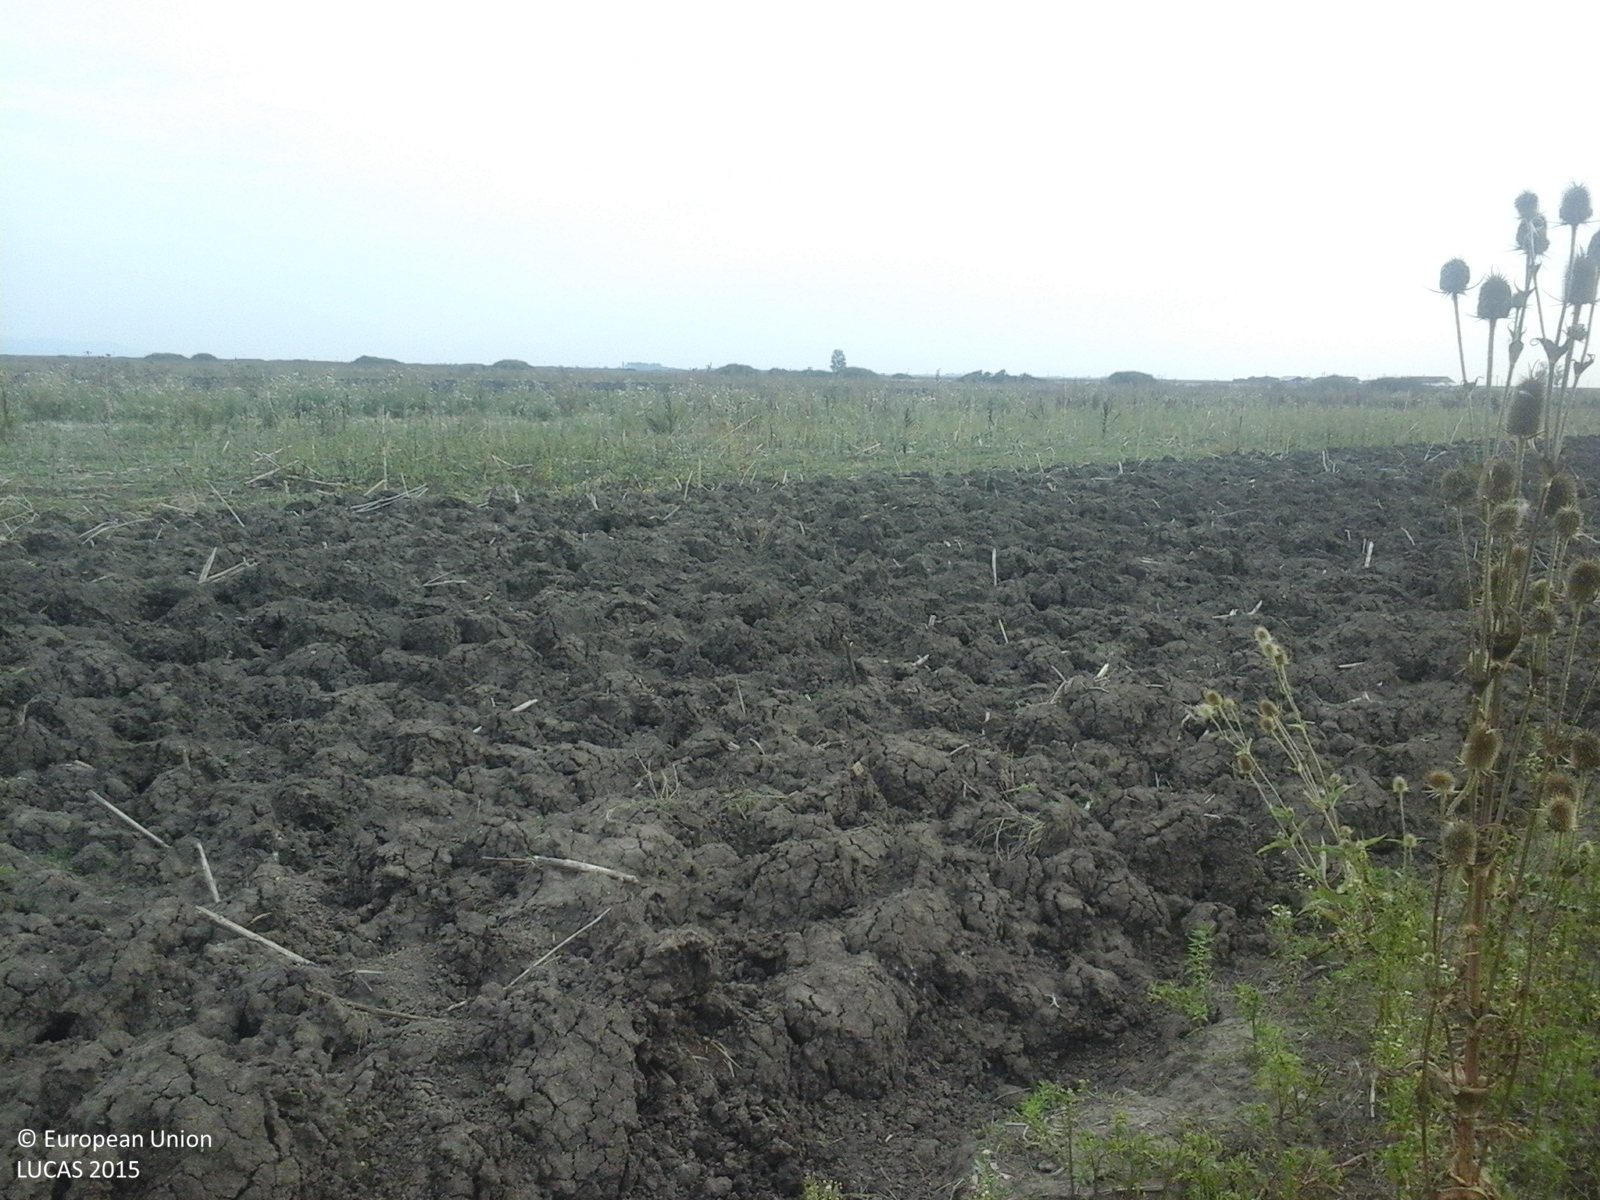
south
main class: Grassland
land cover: Spontaneously vegetated surfaces
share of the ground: > 75 %
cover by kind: herbaceous plants 100 %
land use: Fallow land
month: August
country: RO
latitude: 46.4469
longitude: 21.5852
